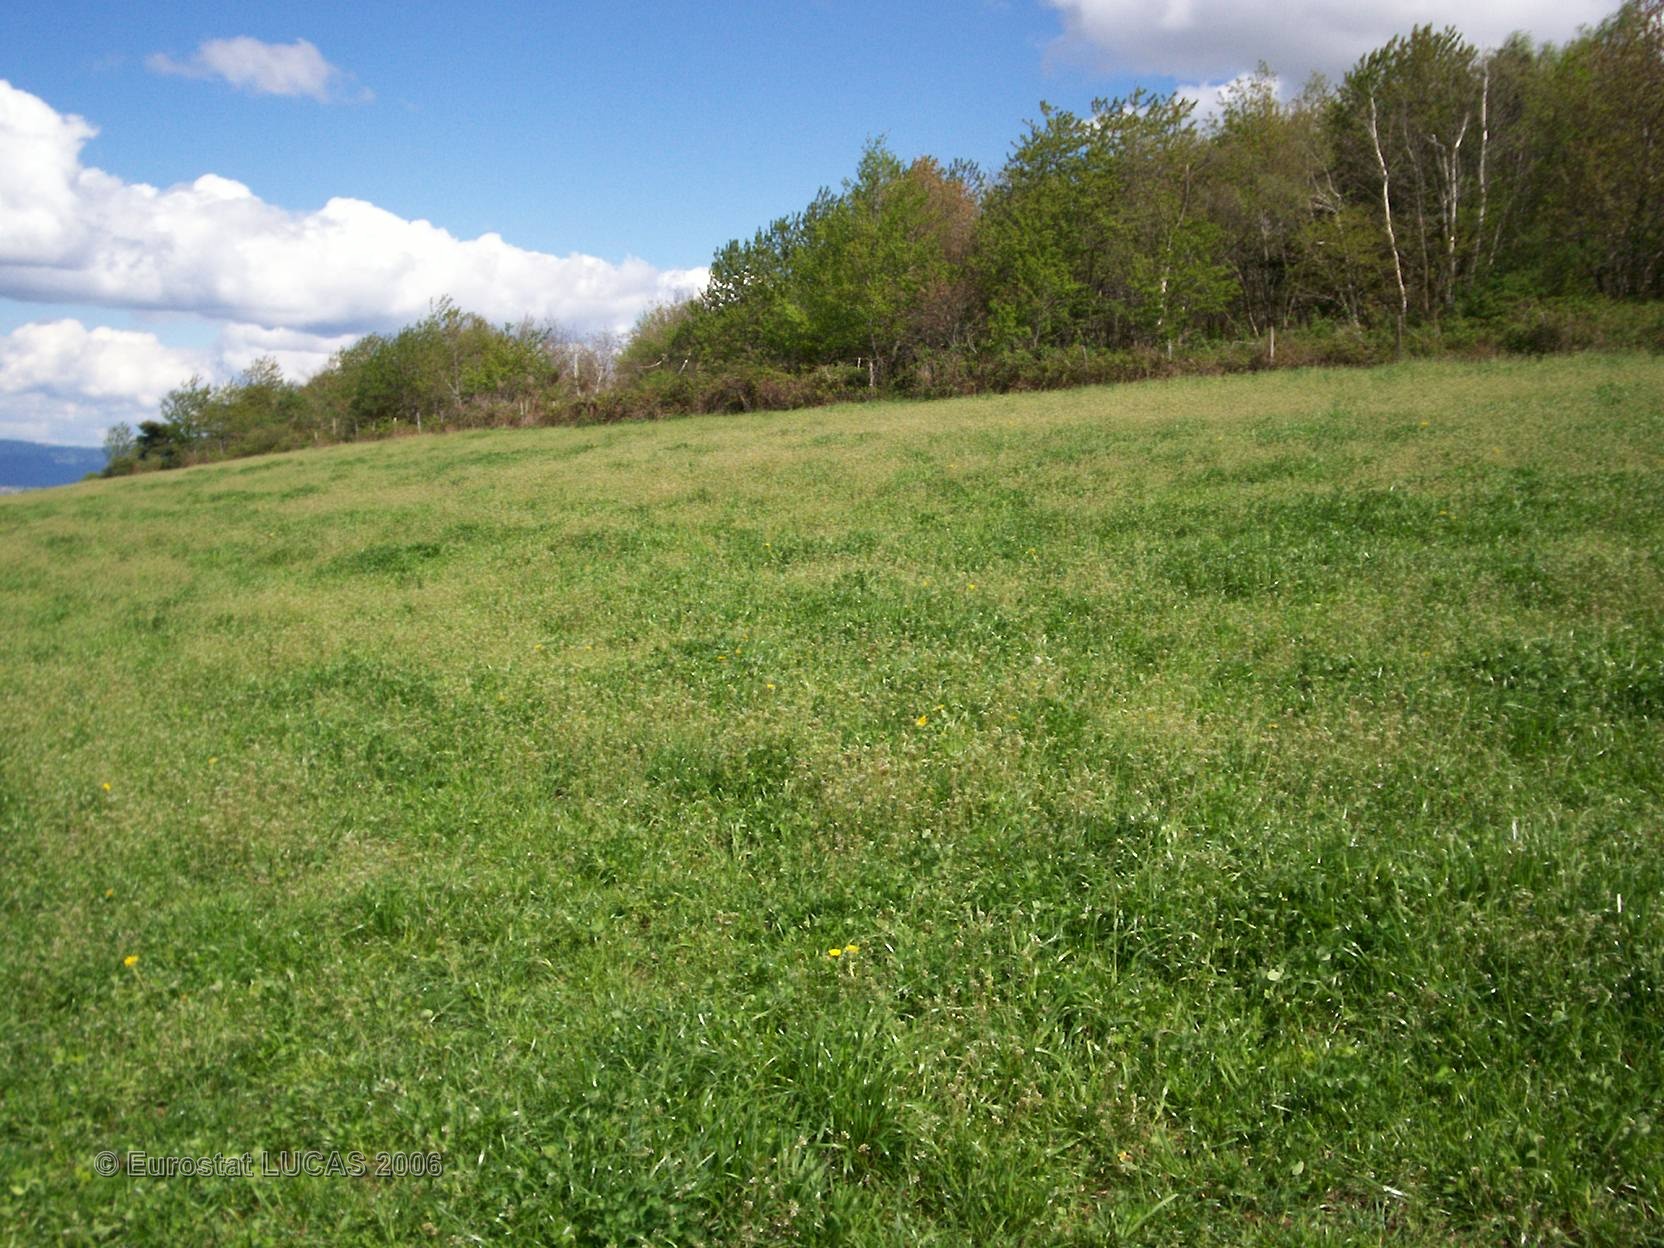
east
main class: Grassland
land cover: Grassland without tree/shrub cover
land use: Agriculture (excluding fallow land and kitchen gardens)
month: May
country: FR
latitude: 45.1859
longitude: 3.3462
